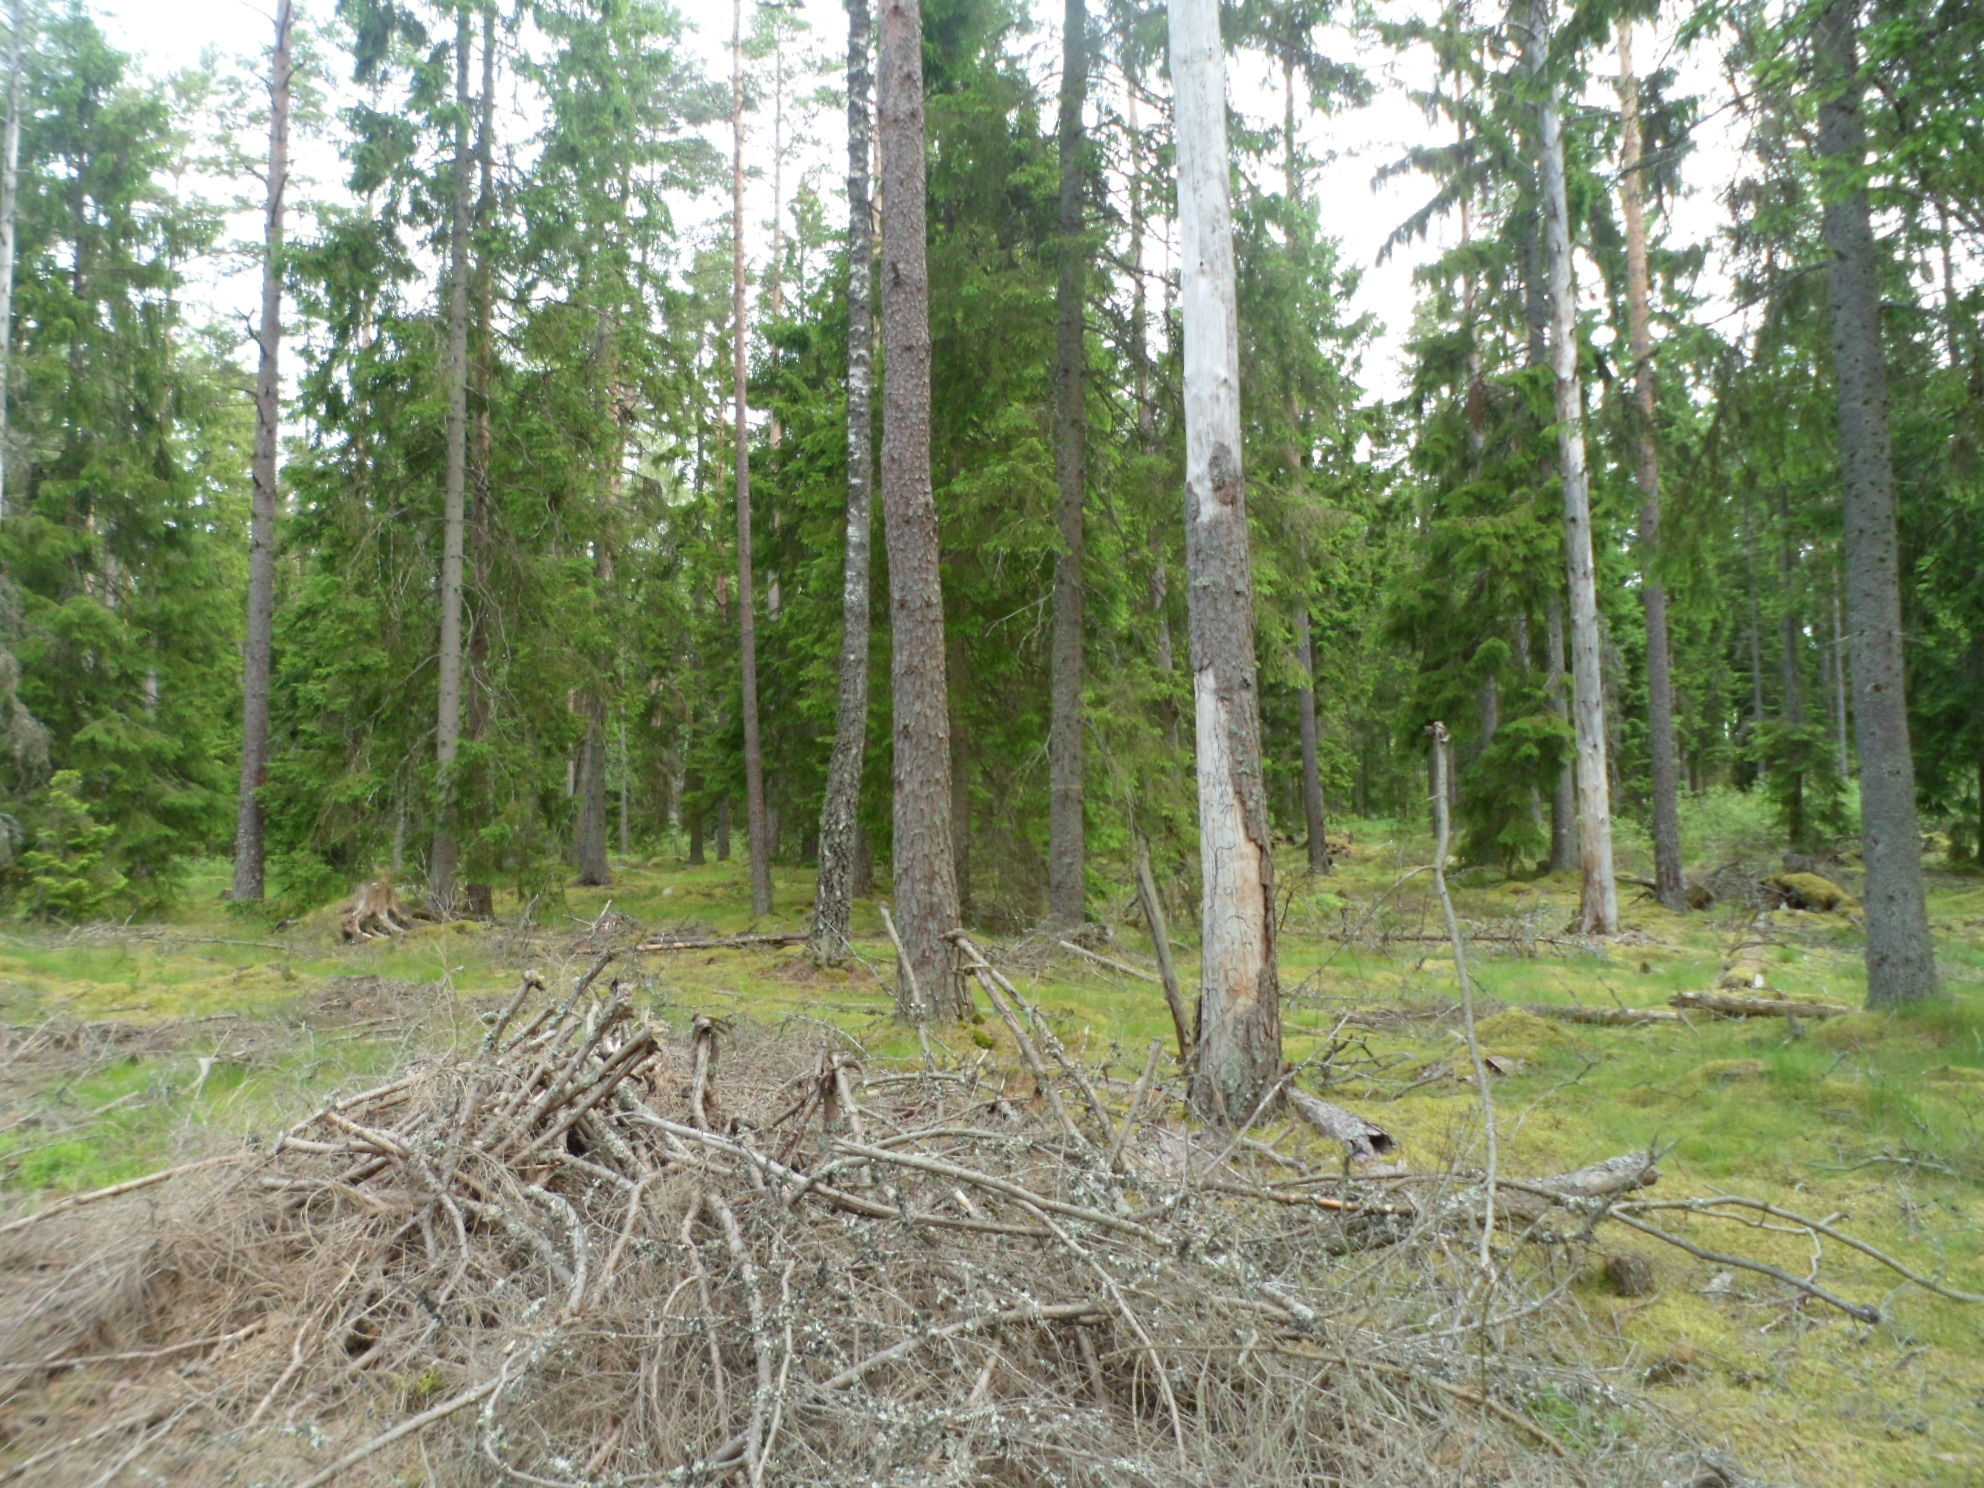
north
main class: Woodland
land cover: Pine dominated coniferous woodland
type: boreal forest
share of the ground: 25 - 50 %
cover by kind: coniferous forest trees 50 %, shrubs 20 %, lichens and mosses 20 %, herbaceous plants 10 %
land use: Forestry
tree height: > 5 m
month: June
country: SE
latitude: 57.0187
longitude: 15.2187
